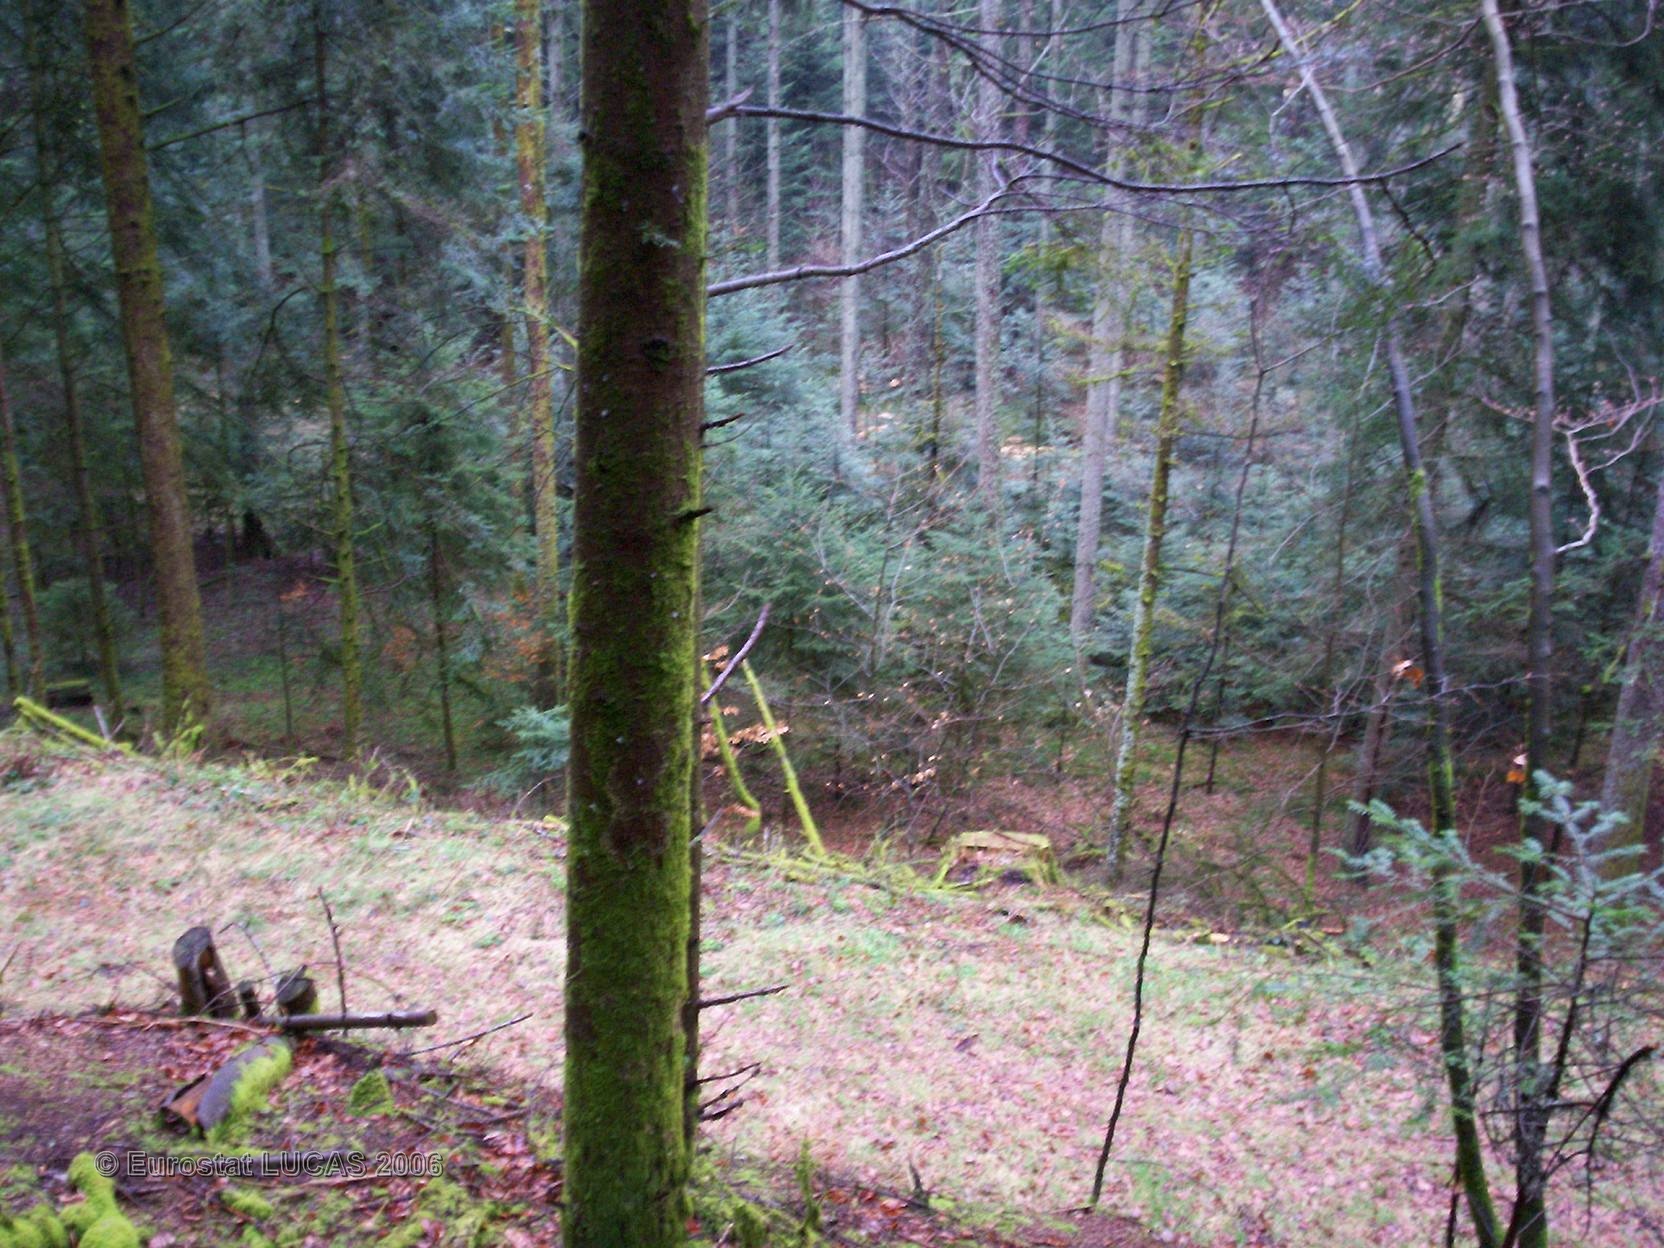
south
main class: Woodland
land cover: Coniferous forest
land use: Forestry
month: April
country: FR
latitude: 47.9897
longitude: 6.5572
